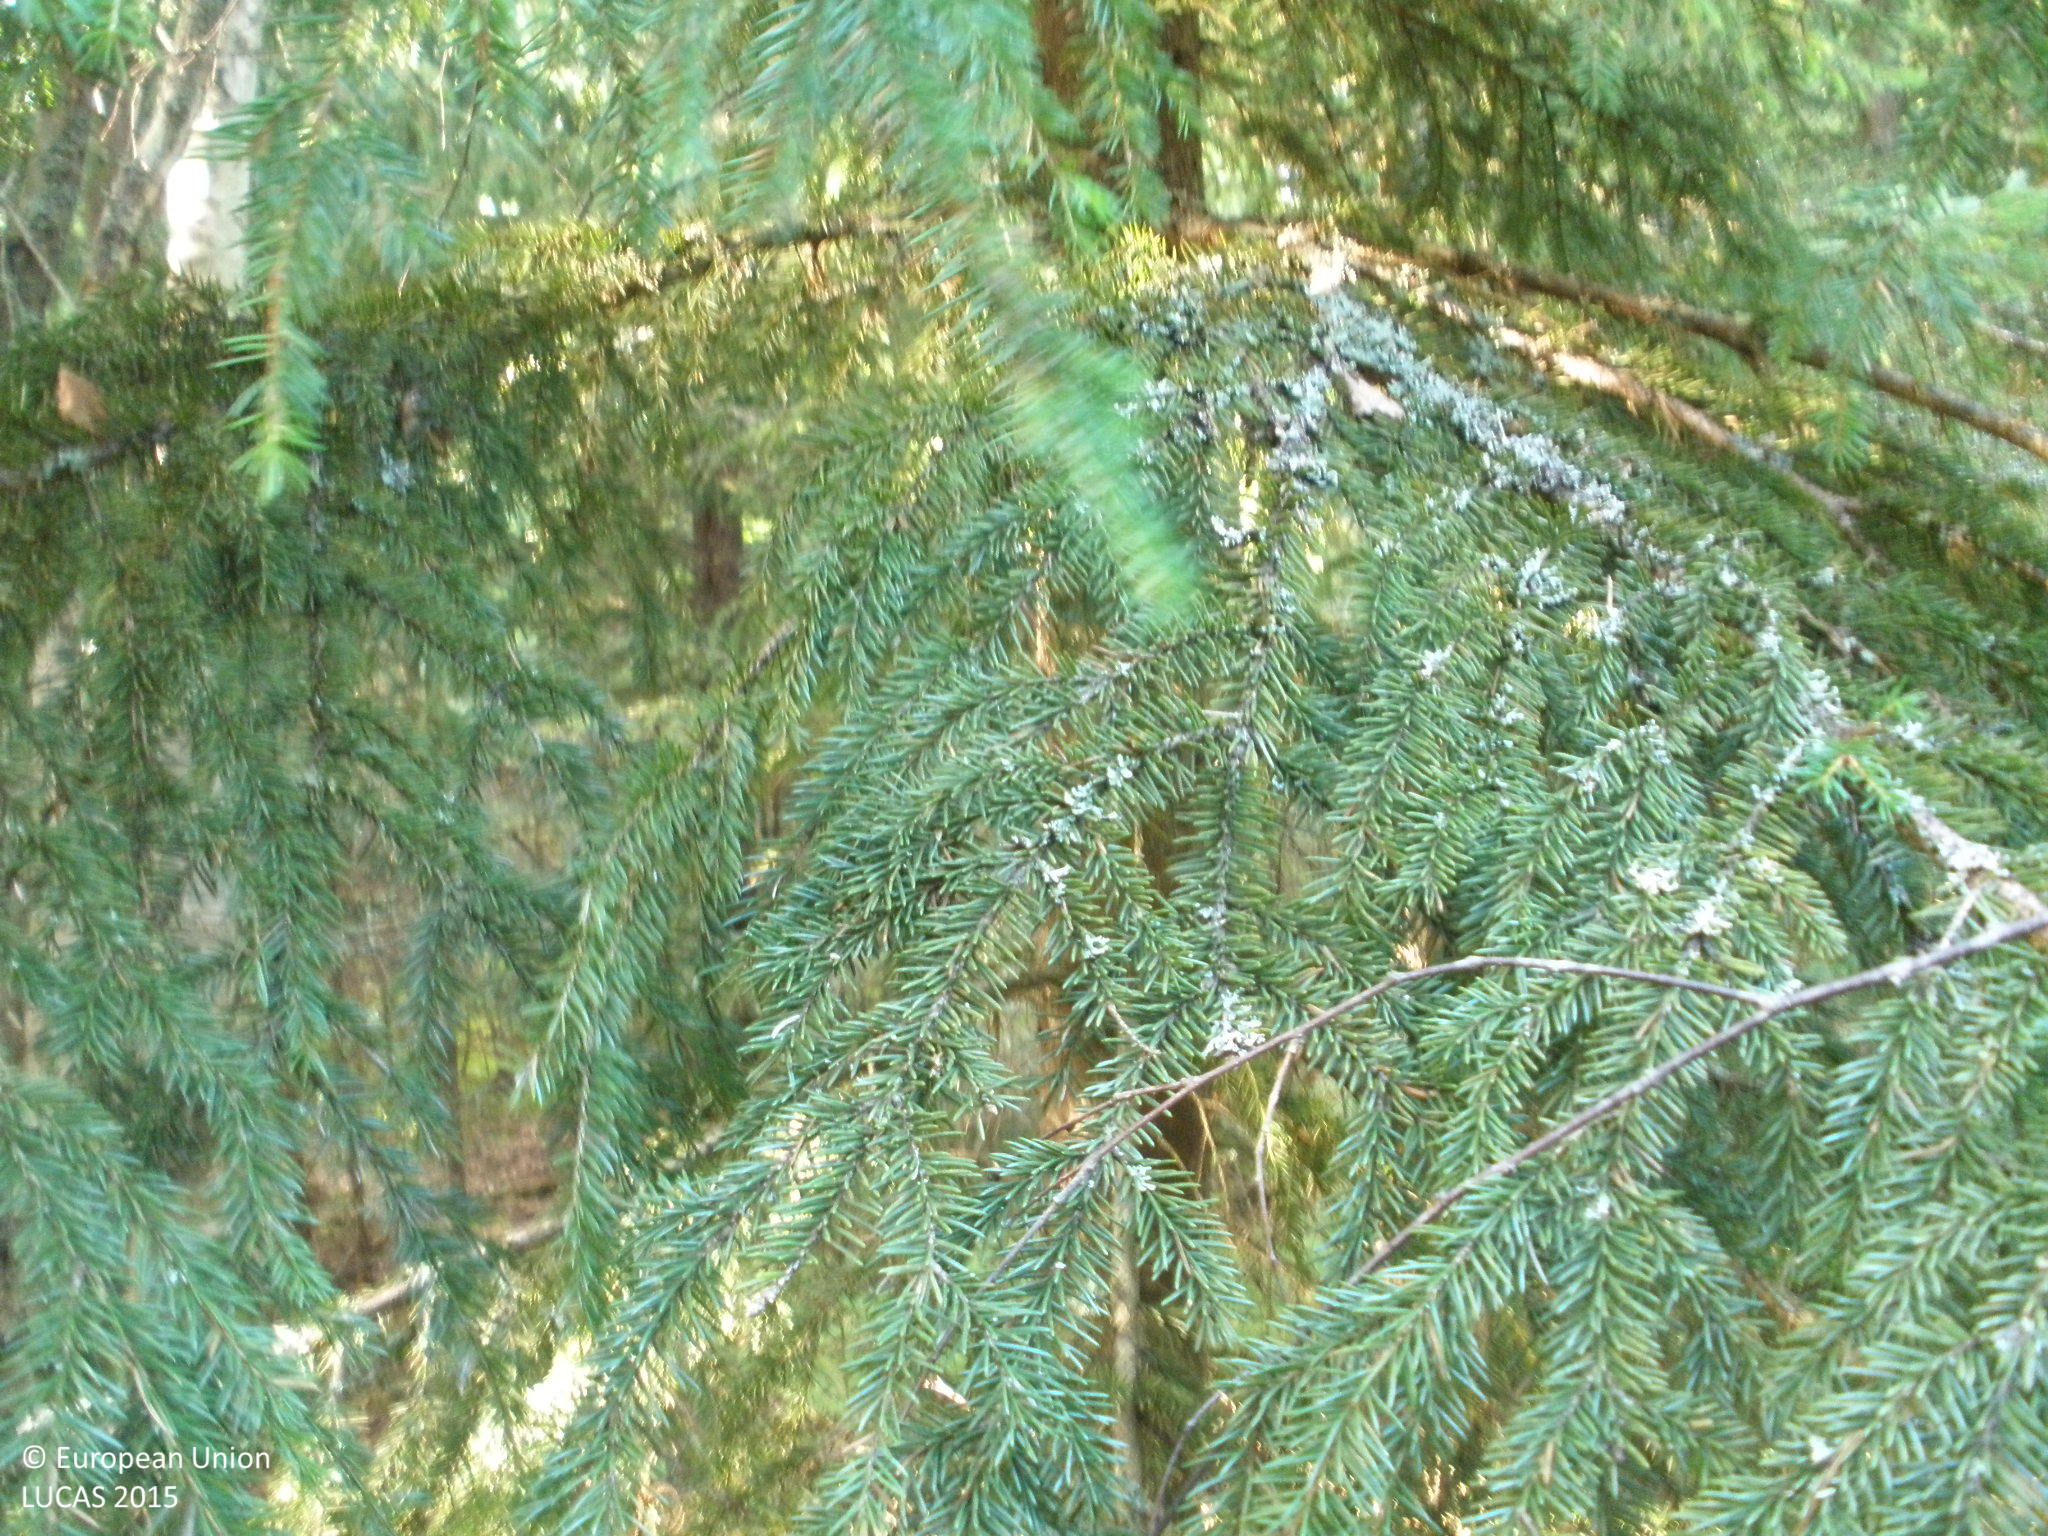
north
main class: Woodland
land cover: Spruce dominated mixed woodland
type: boreal forest
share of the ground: > 75 %
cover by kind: coniferous forest trees 60 %, broadleaved forest trees 25 %, herbaceous plants 10 %, lichens and mosses 5 %
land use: Forestry
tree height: > 5 m
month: August
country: FI
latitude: 60.7050
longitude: 24.3744
